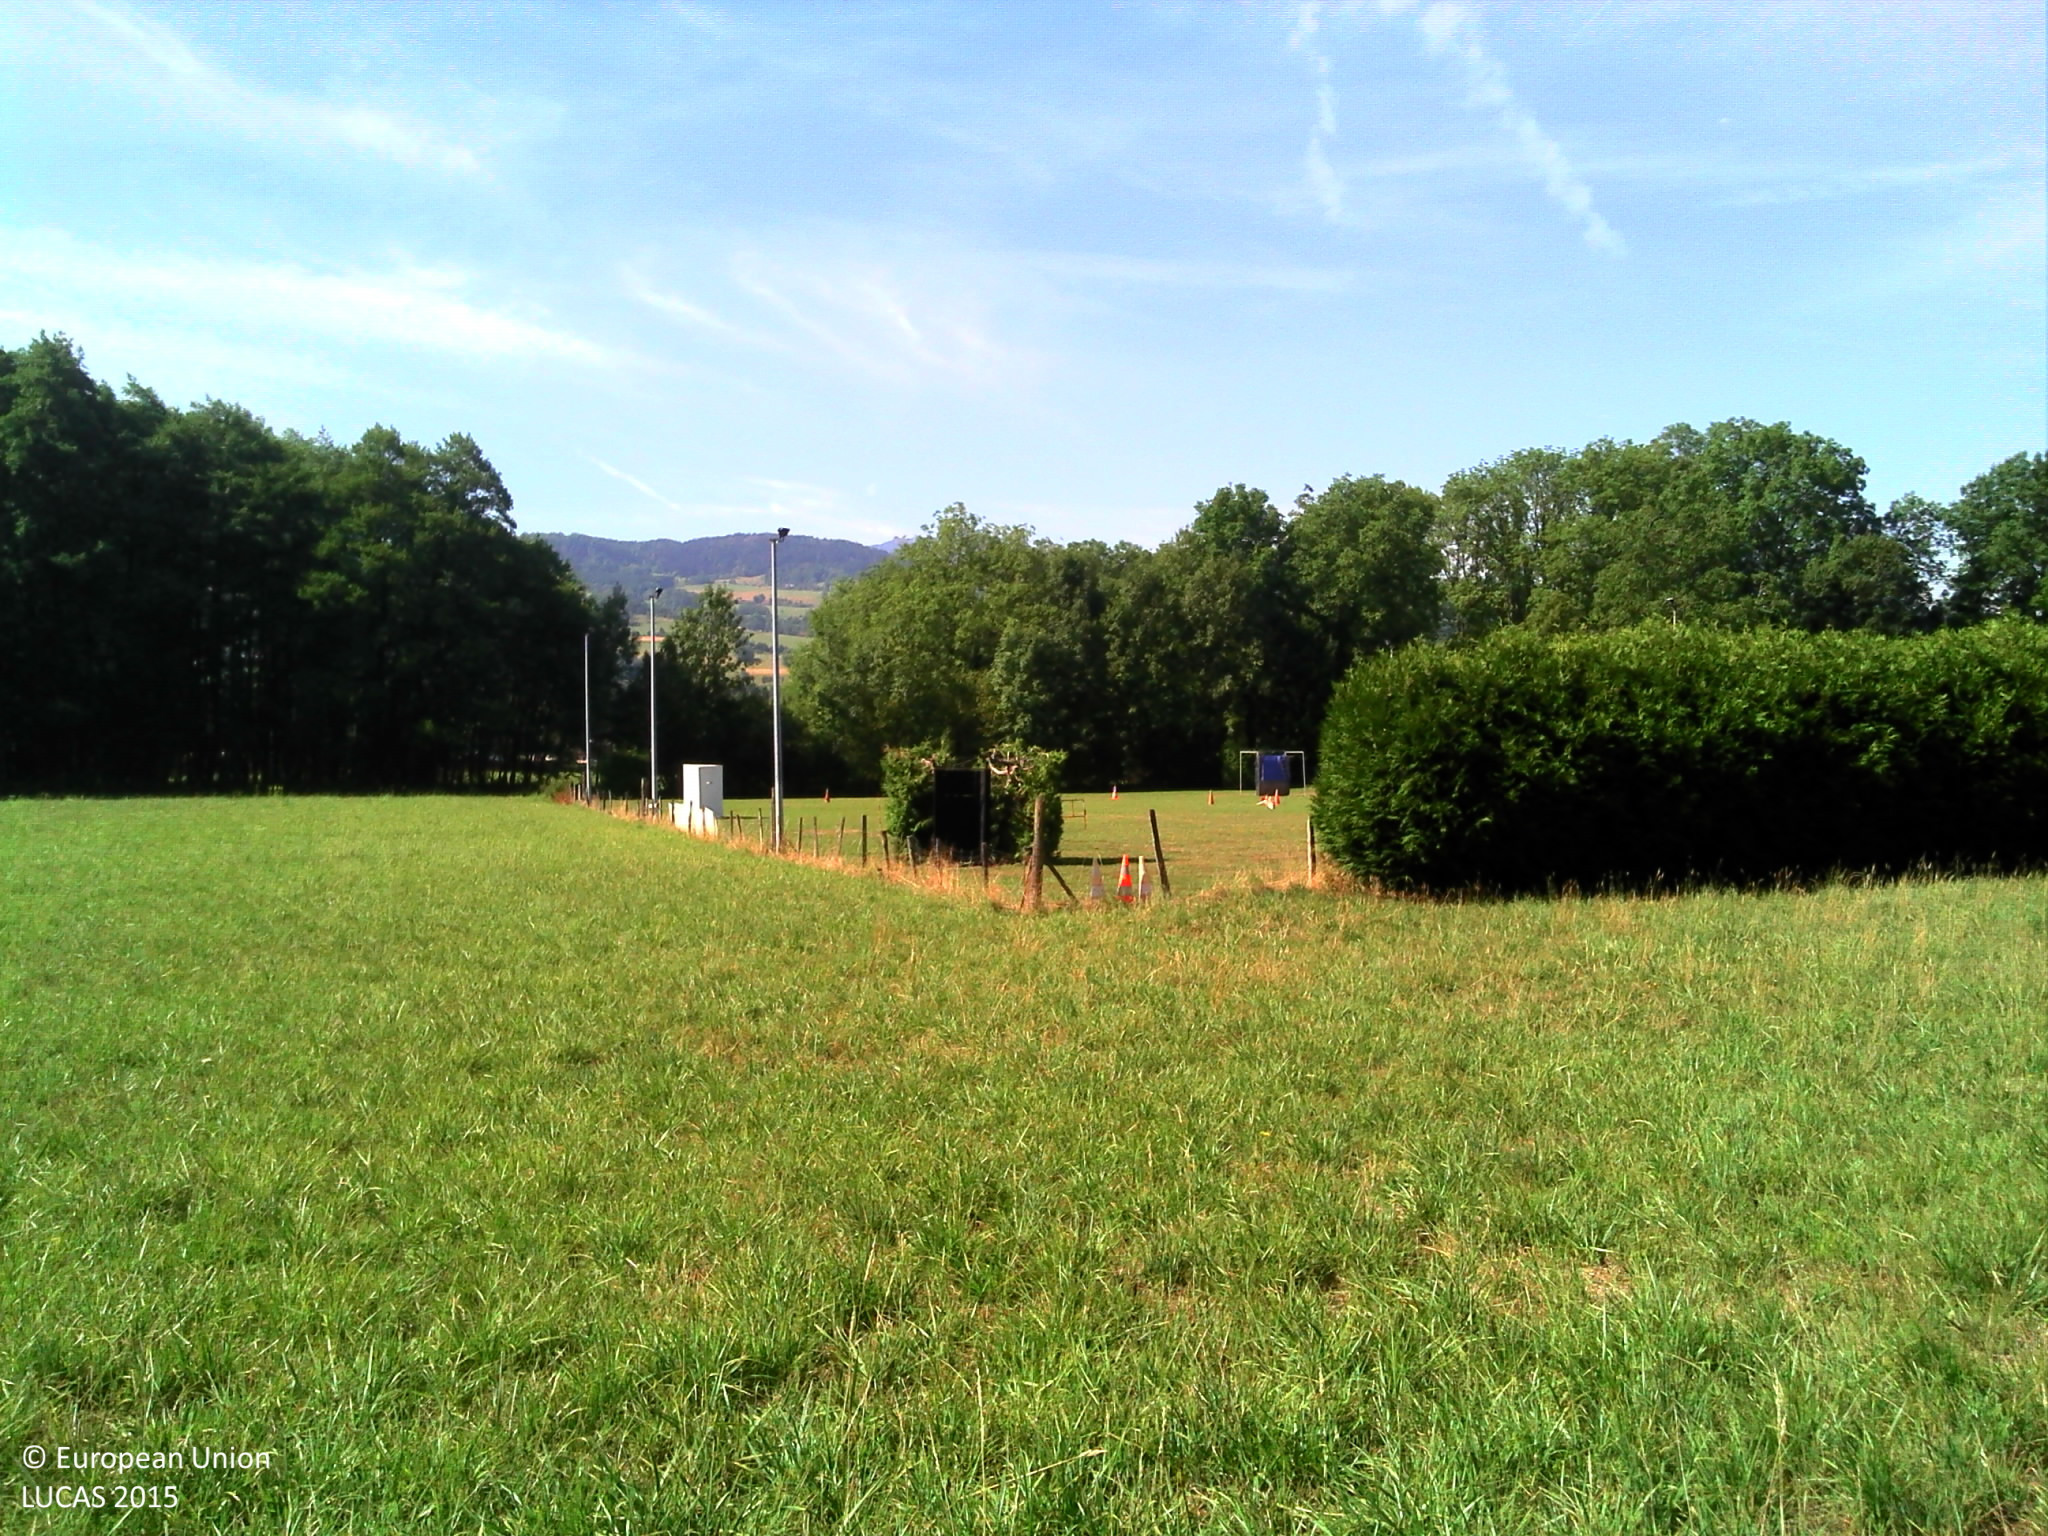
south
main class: Grassland
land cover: Grassland without tree/shrub cover
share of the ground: > 75 %
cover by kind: herbaceous plants 100 %
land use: Agriculture (excluding fallow land and kitchen gardens)
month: July
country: FR
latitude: 46.1470
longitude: 6.4173
